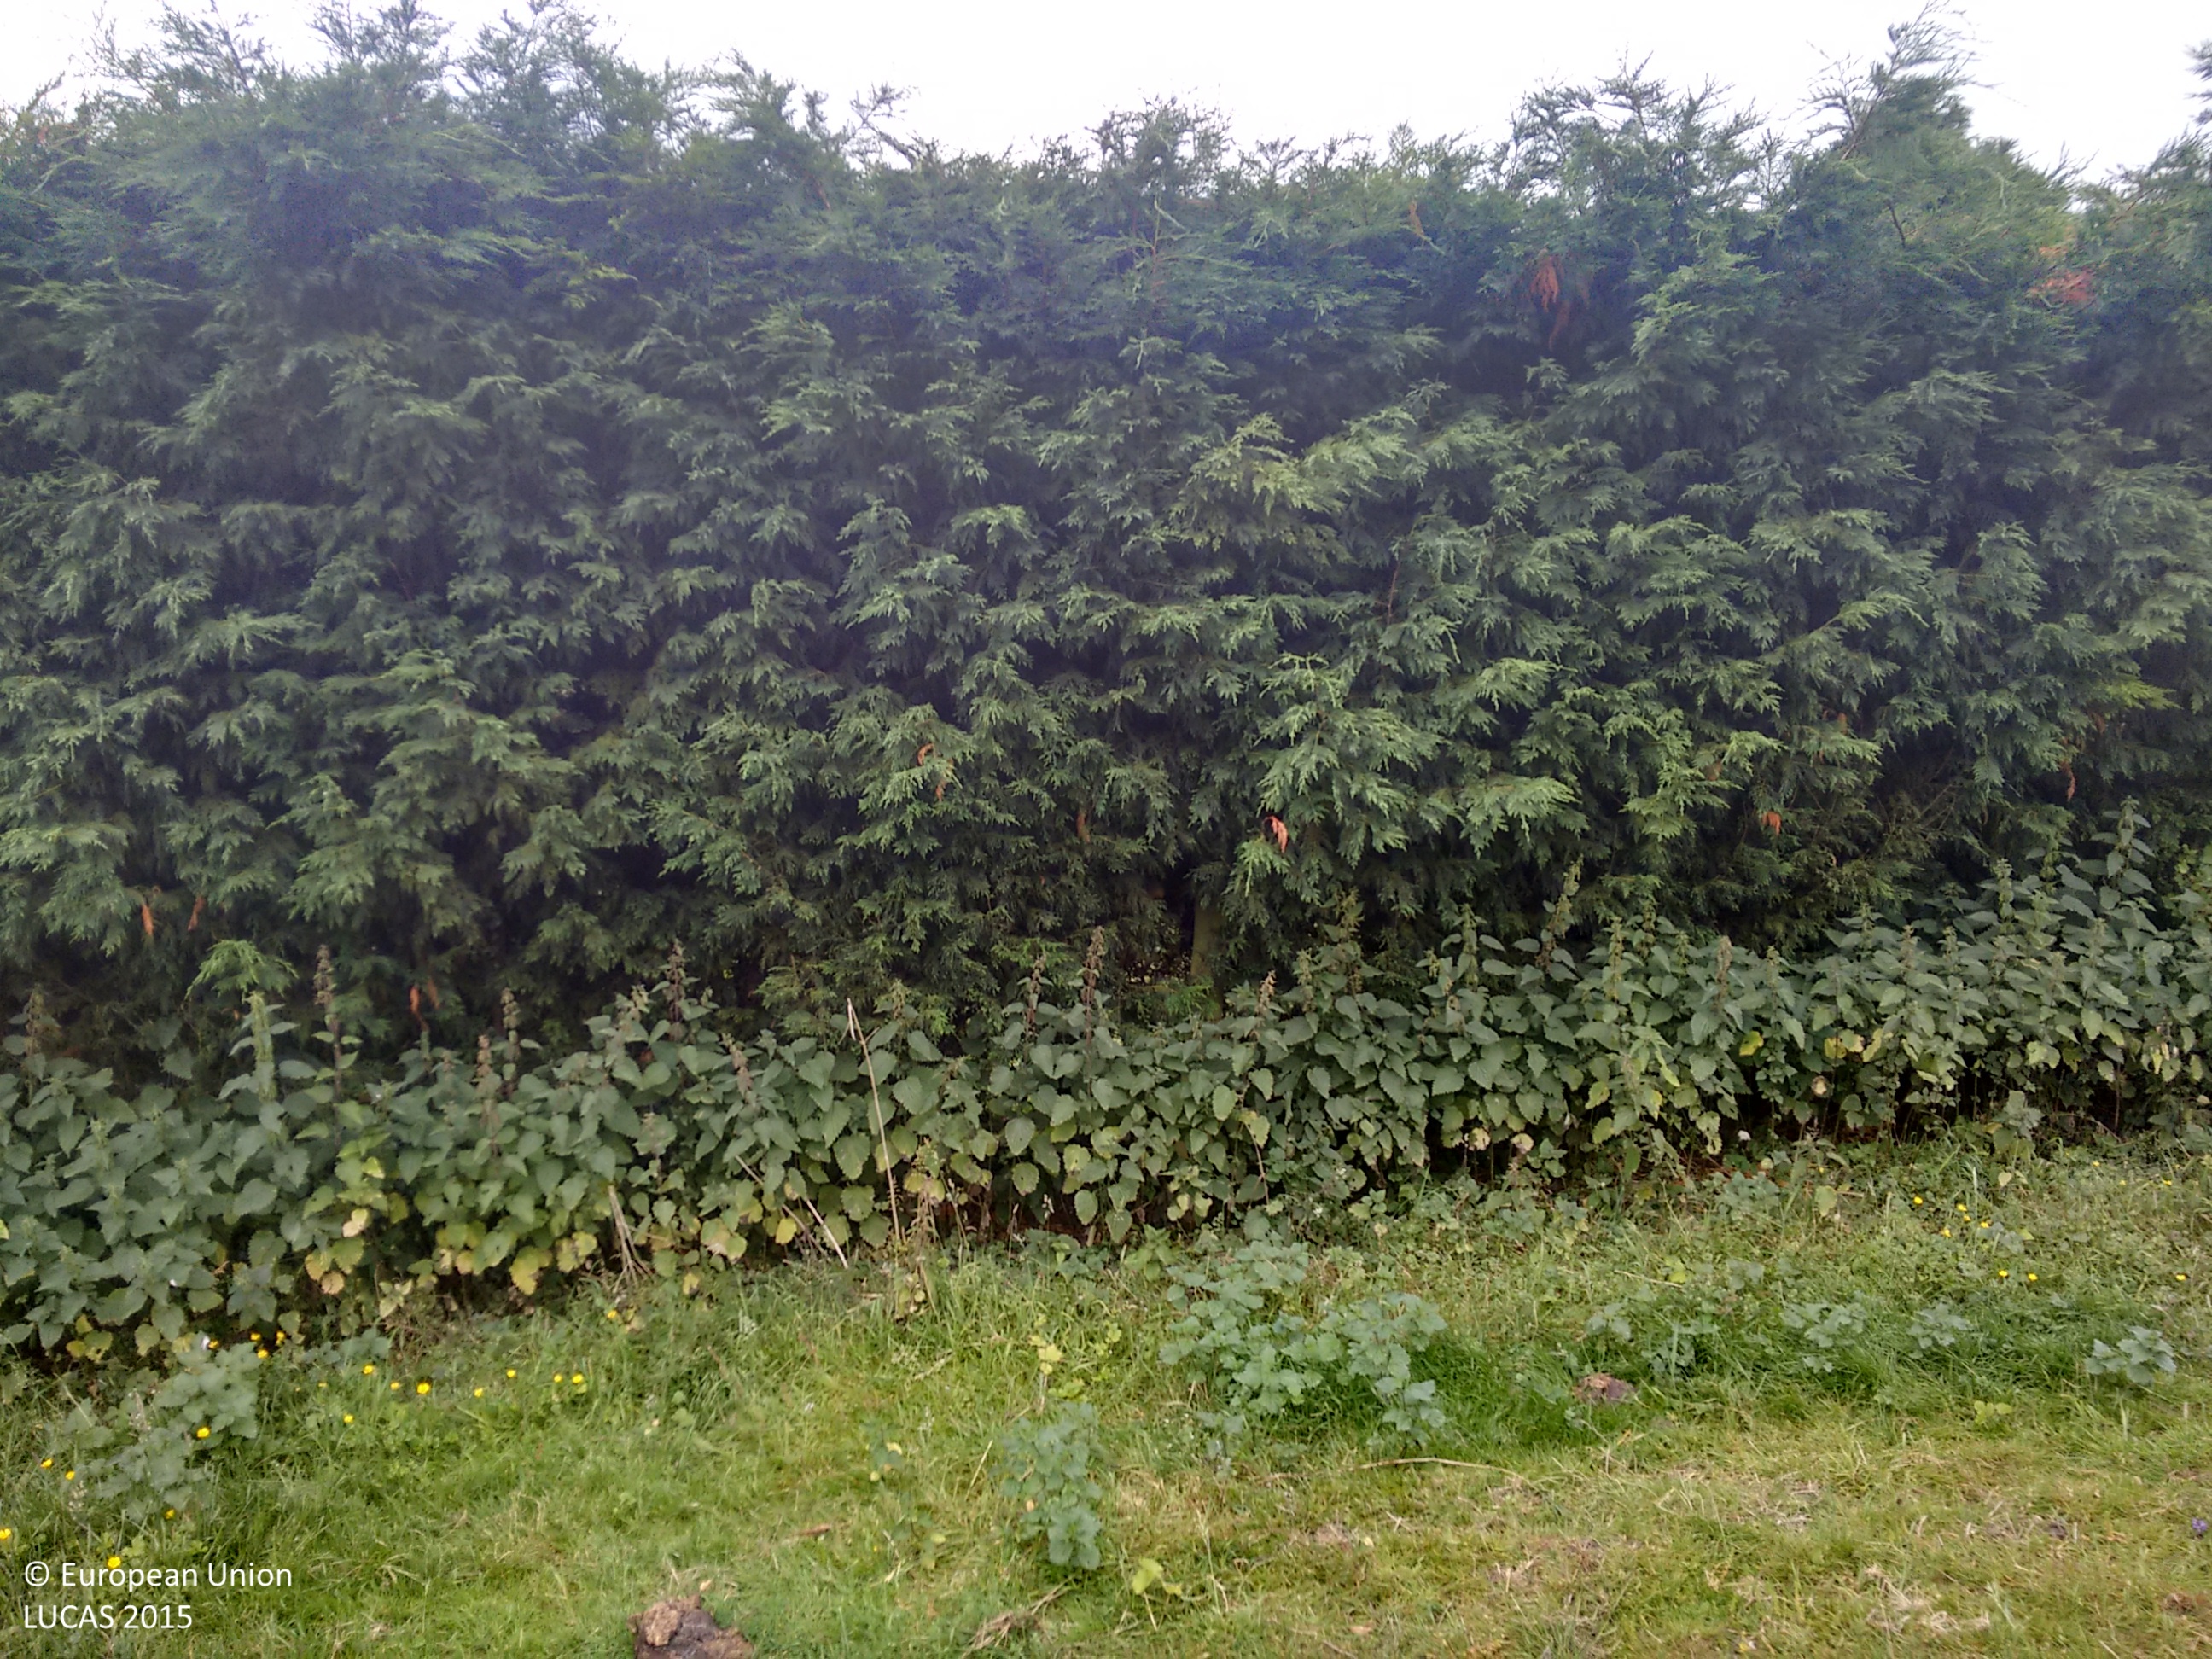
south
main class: Grassland
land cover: Grassland without tree/shrub cover
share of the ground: > 75 %
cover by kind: herbaceous plants 100 %
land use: Agriculture (excluding fallow land and kitchen gardens)
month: July
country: GB
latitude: 50.9189
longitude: -0.4359
